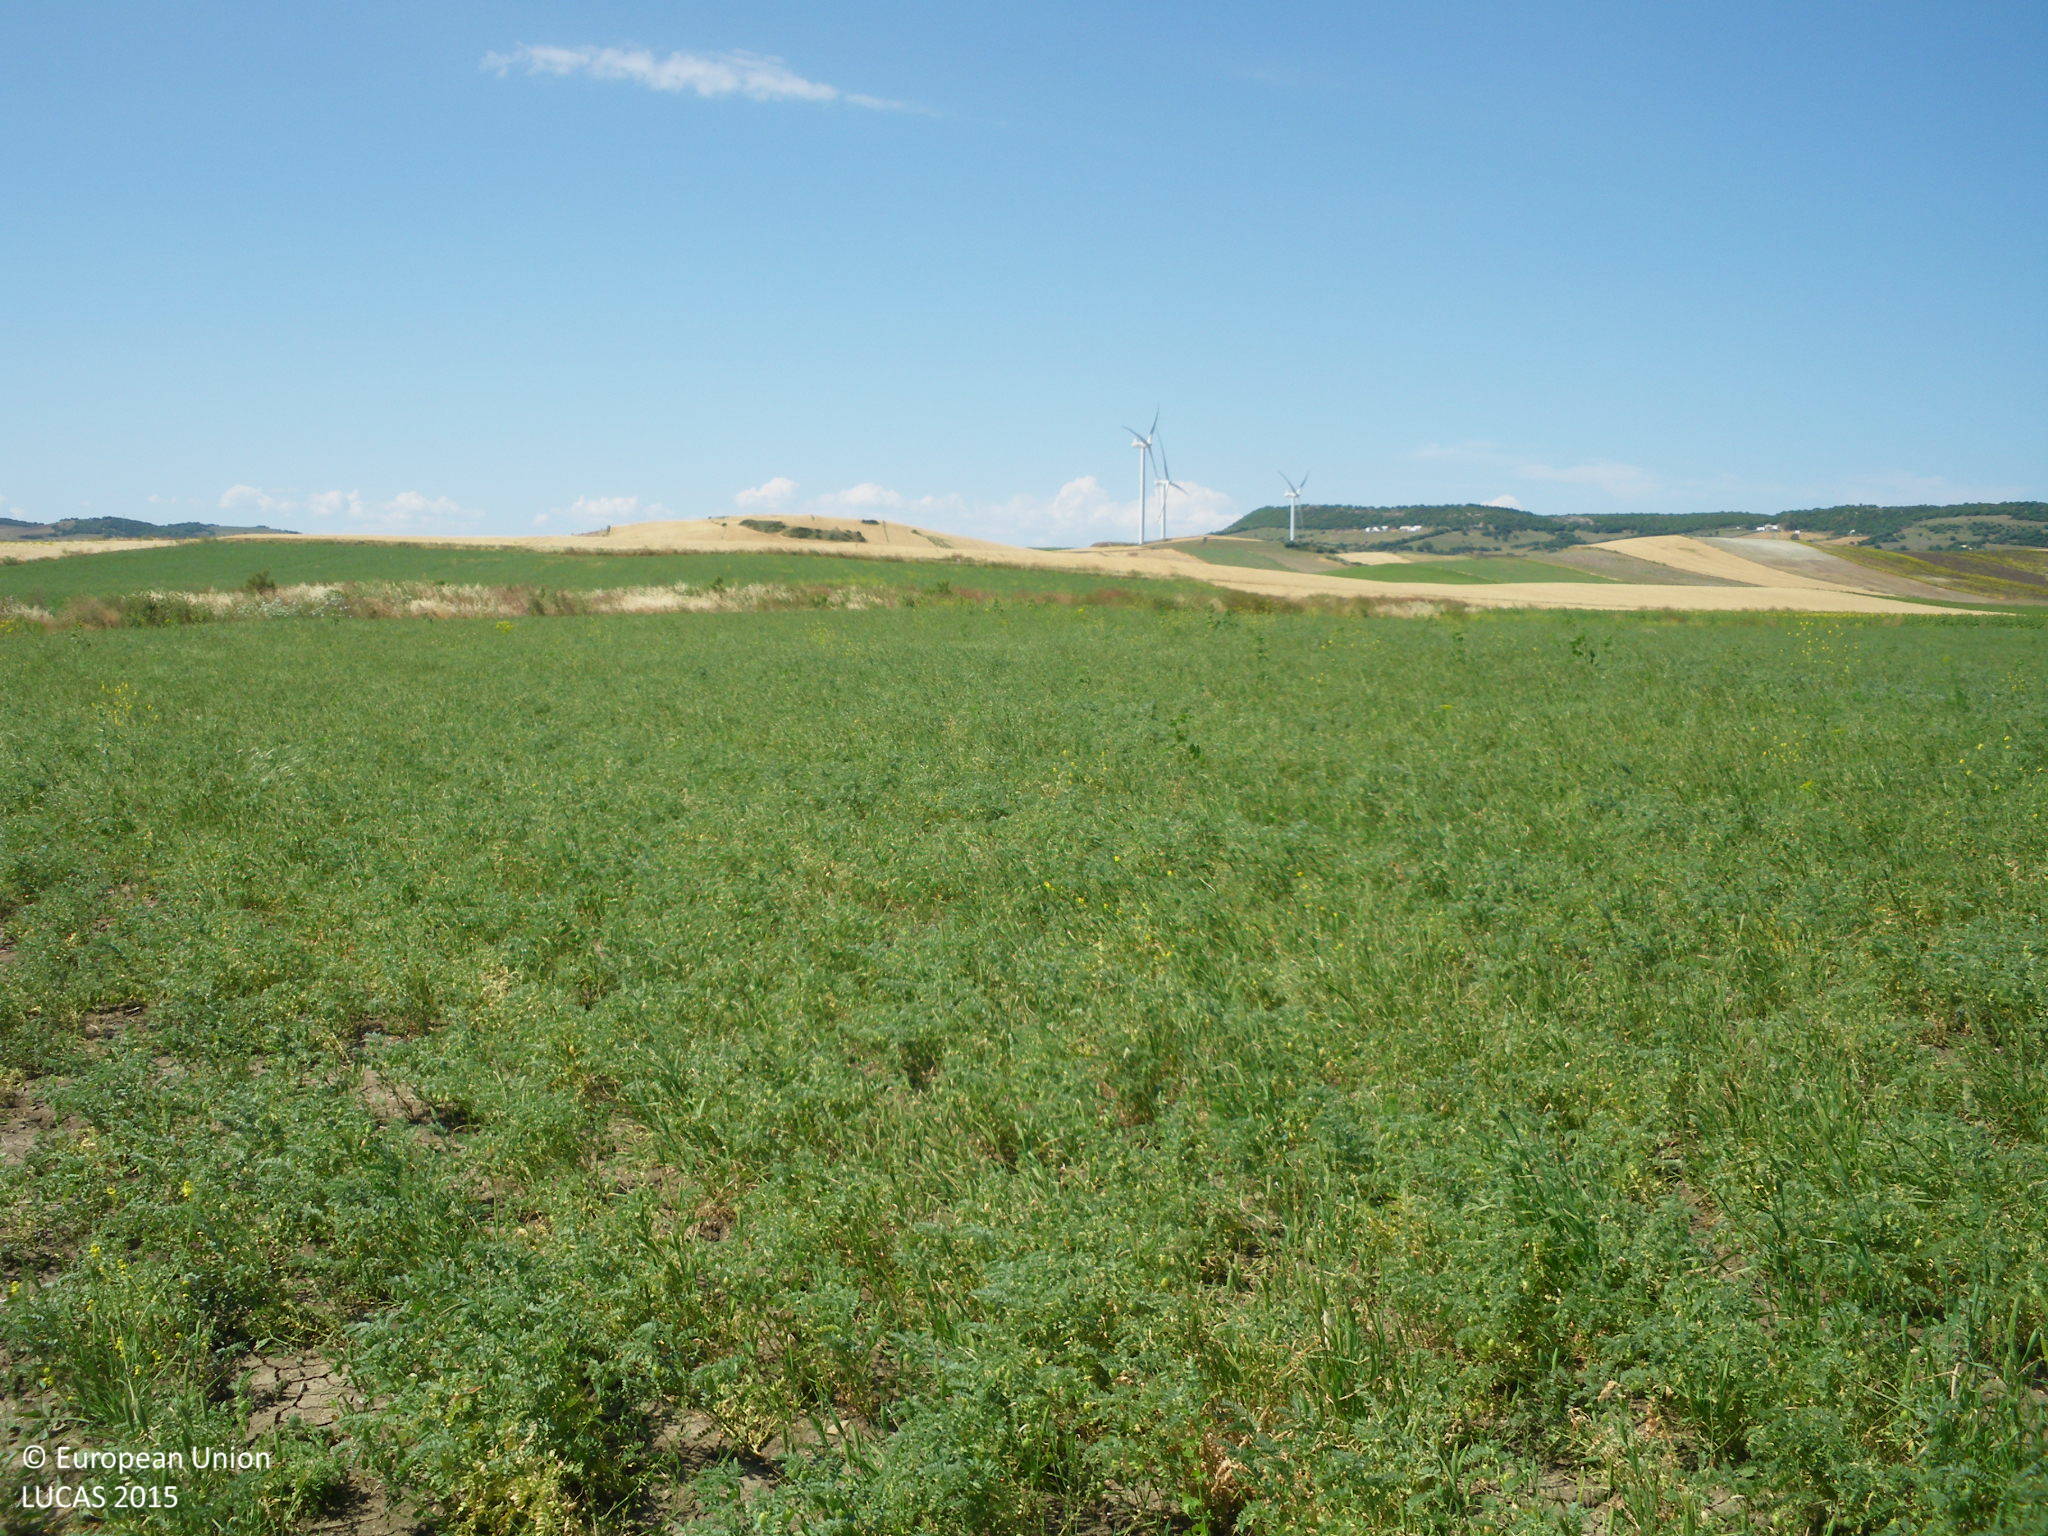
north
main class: Cropland
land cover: Dry pulses
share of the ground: 50 - 75 %
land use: Agriculture (excluding fallow land and kitchen gardens)
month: May
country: ES
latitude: 36.3234
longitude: -5.9193
